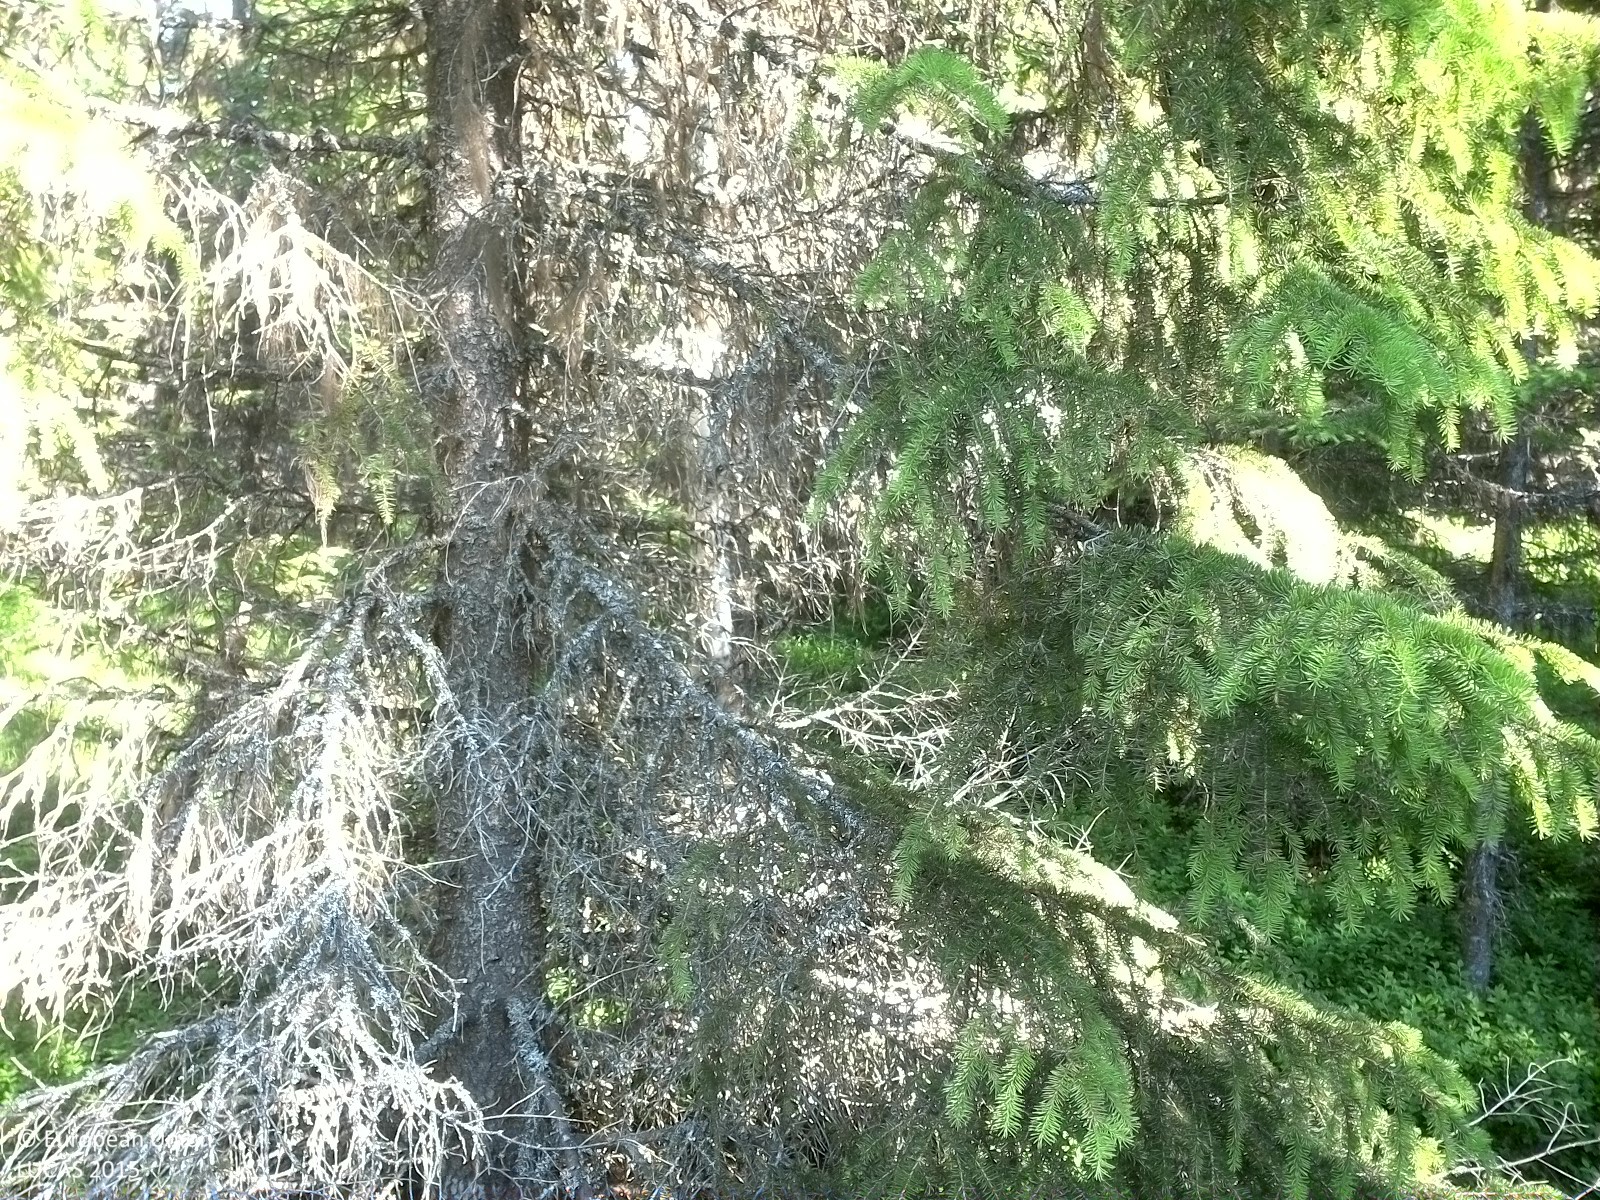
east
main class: Woodland
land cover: Spruce dominated coniferous woodland
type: boreal forest
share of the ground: 50 - 75 %
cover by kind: coniferous forest trees 75 %, shrubs 25 %
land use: Forestry
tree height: > 5 m
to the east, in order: Spruce dominated coniferous woodland; Paved roads, cycling and walking lanes; Spruce dominated coniferous woodland
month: July
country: SE
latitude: 63.5934
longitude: 15.0746
